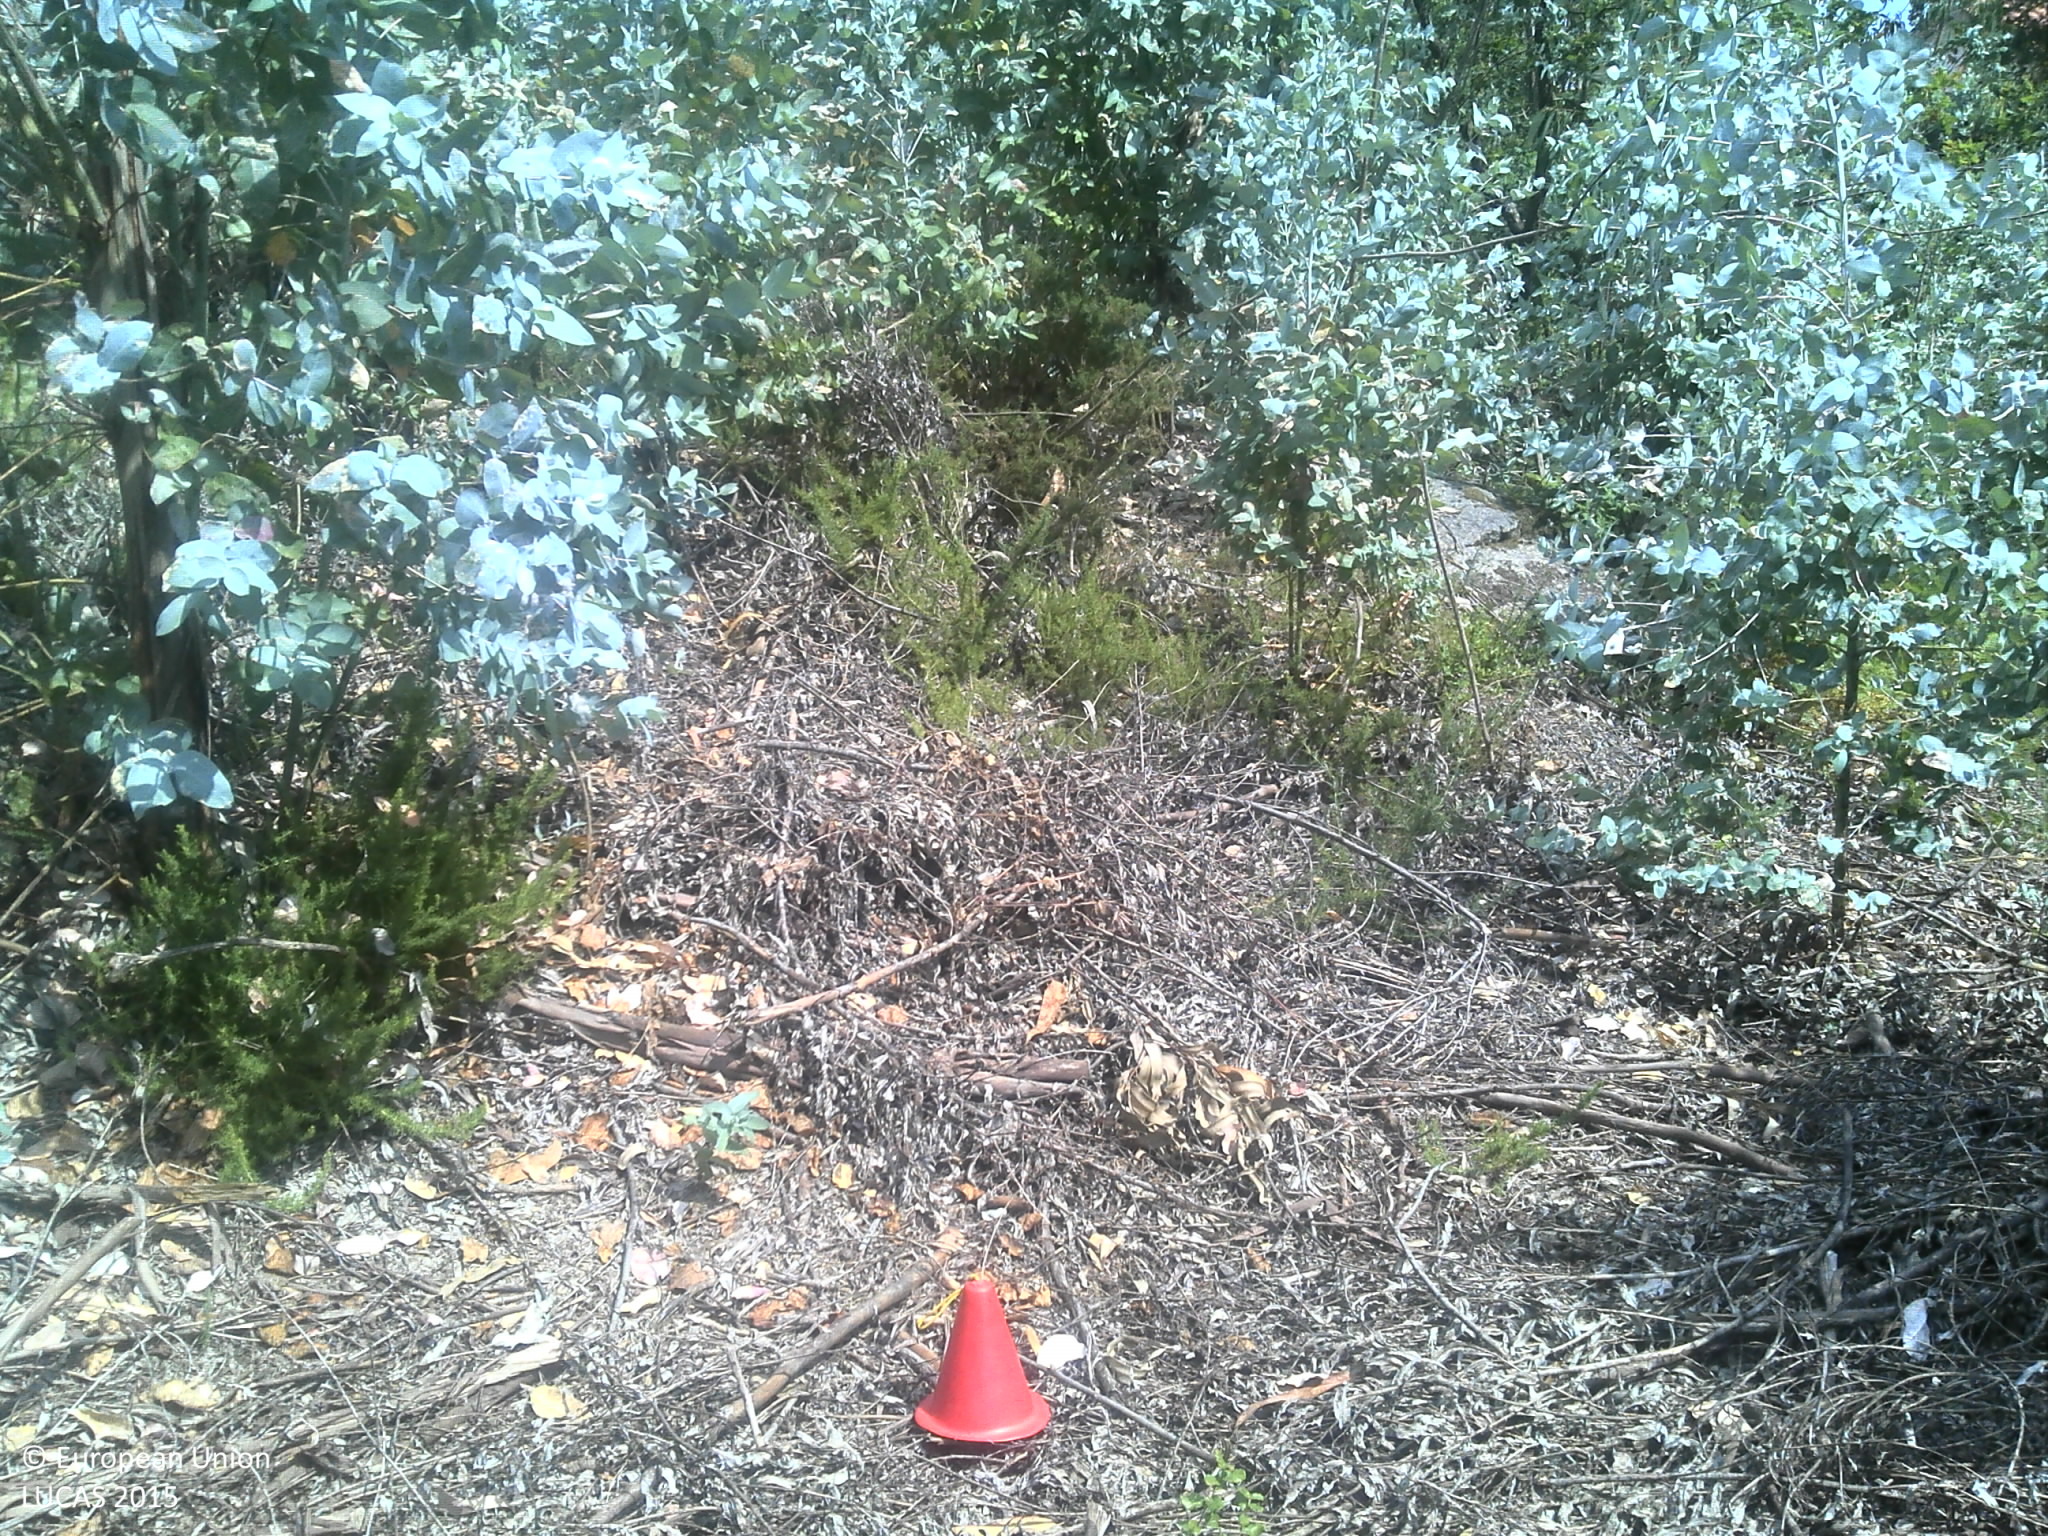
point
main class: Woodland
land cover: Broadleaved woodland
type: exotic forest
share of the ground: 25 - 50 %
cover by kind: broadleaved forest trees 50 %, unconsolidated bare surface 40 %, shrubs 10 %
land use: Forestry
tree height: < 5 m
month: June
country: PT
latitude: 41.5666
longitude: -8.5657
